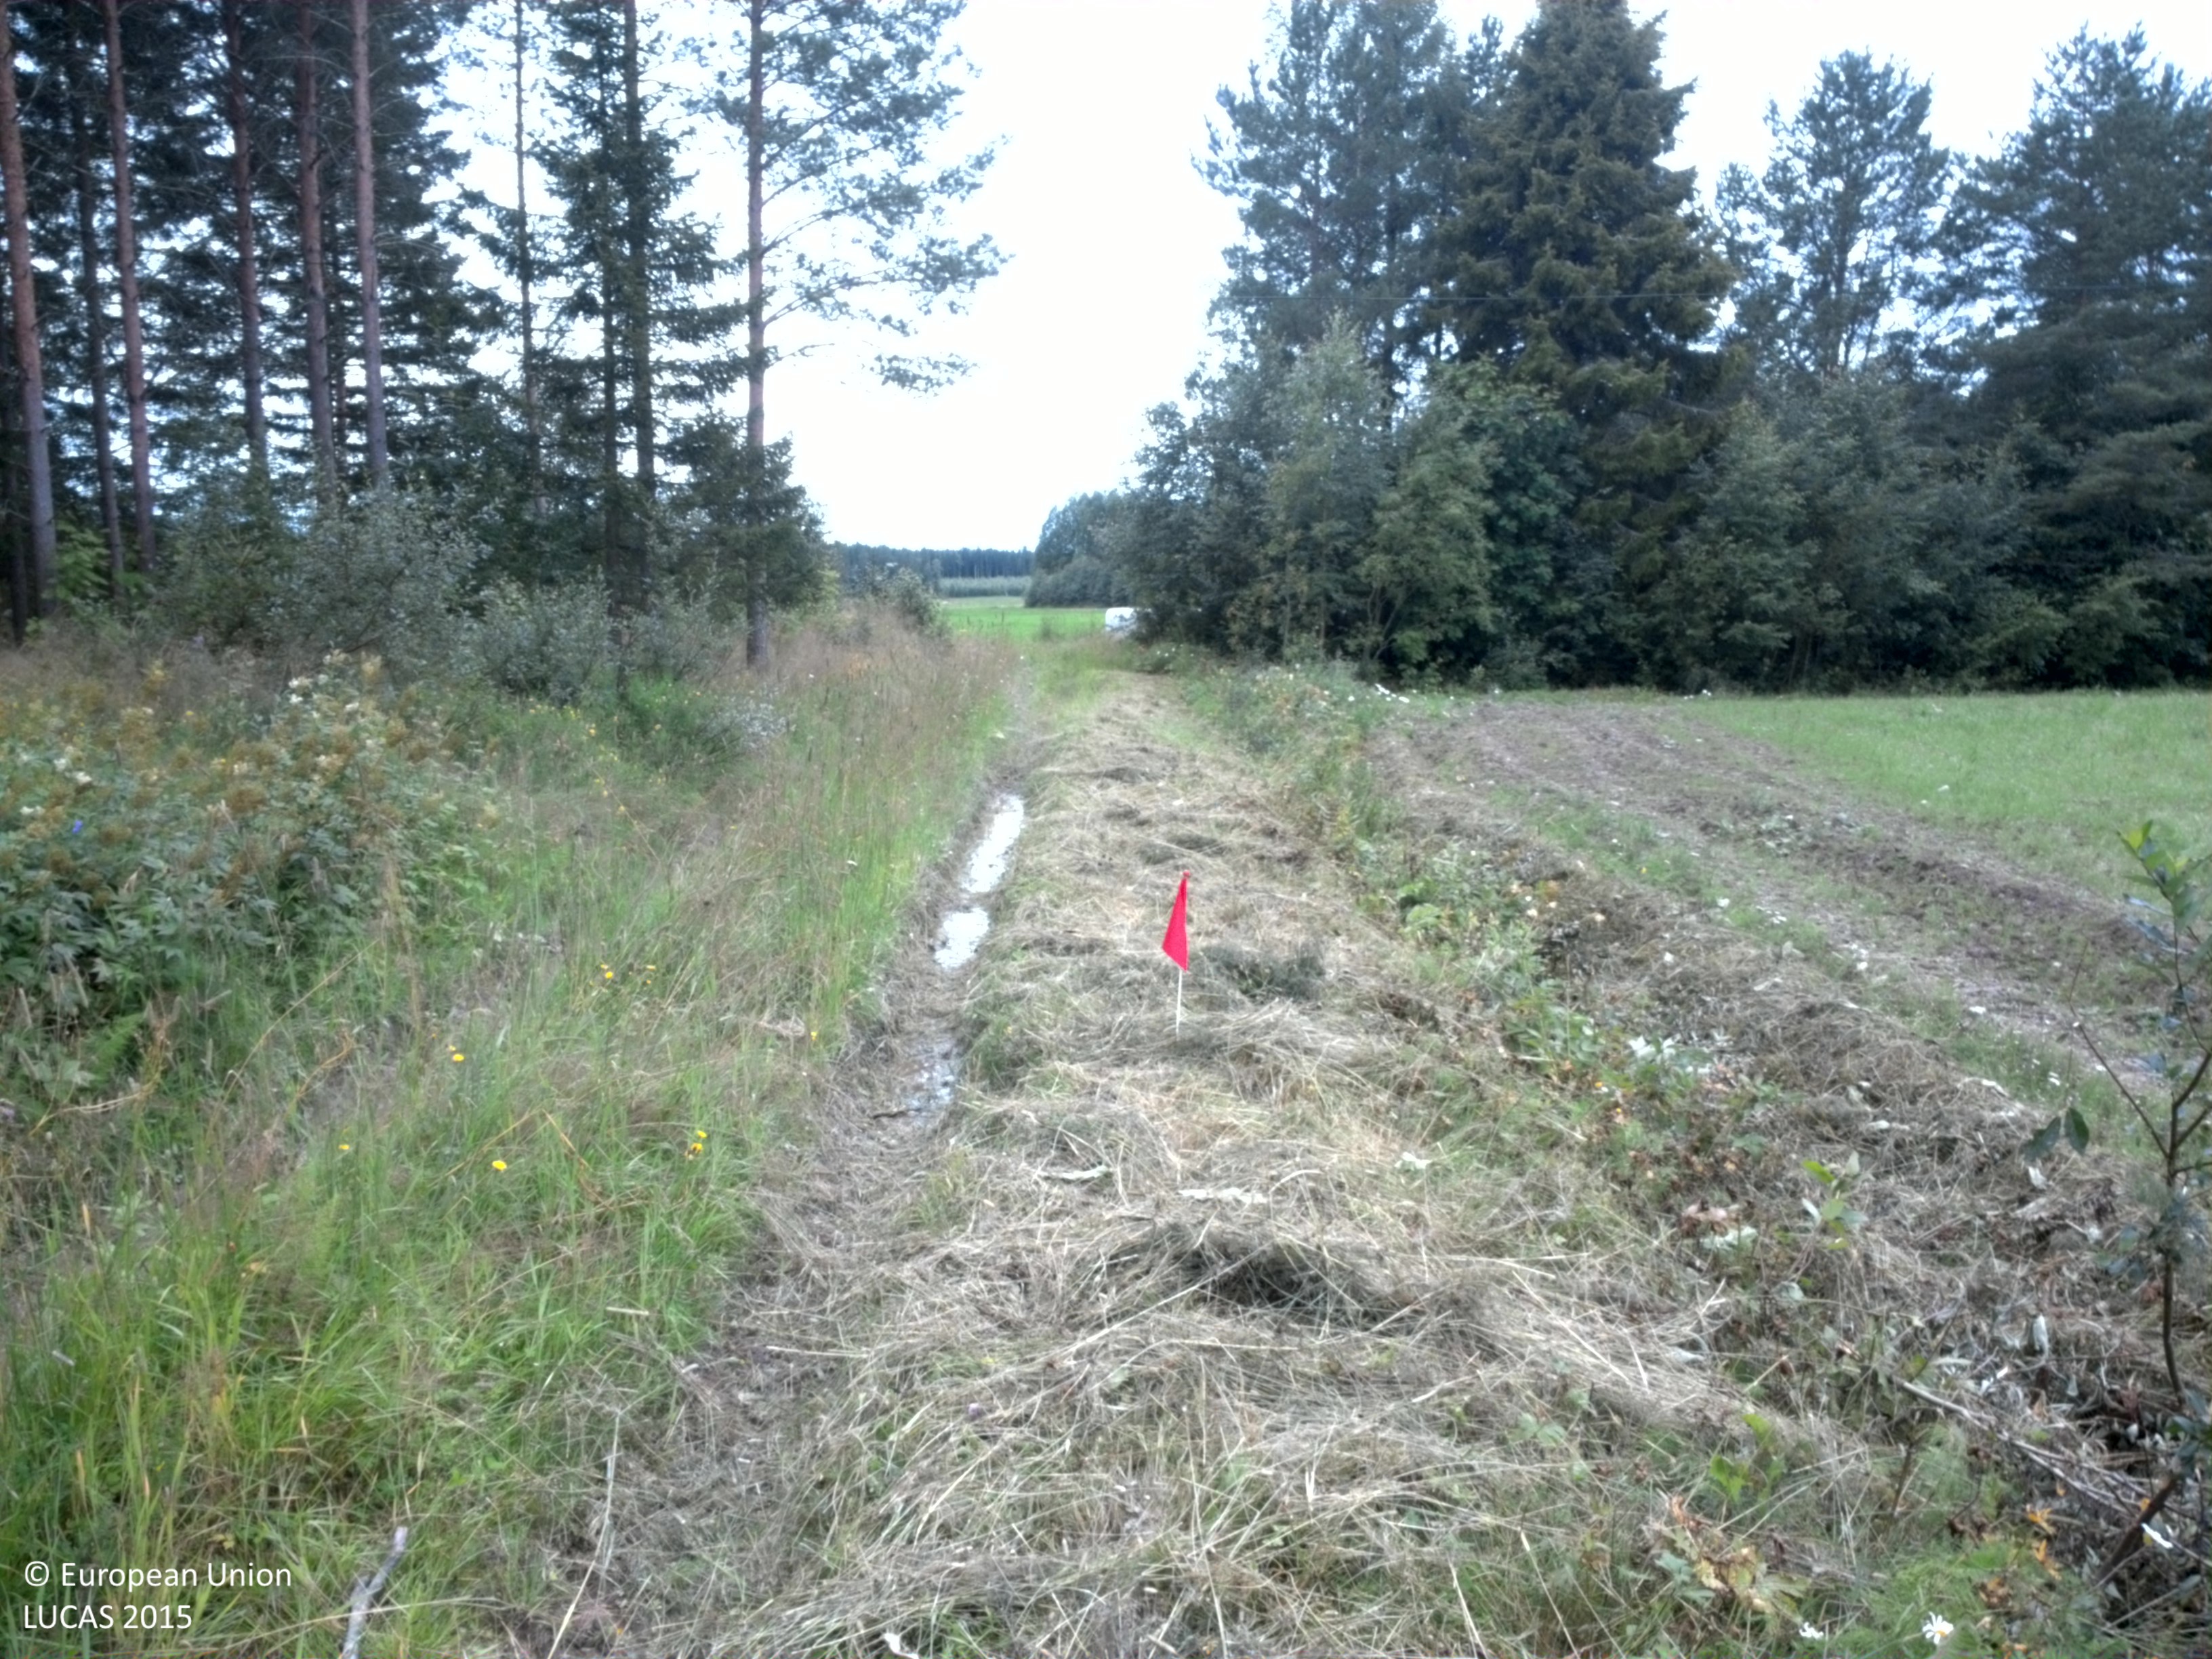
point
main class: Cropland
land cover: Temporary grasslands
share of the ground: > 75 %
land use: Agriculture (excluding fallow land and kitchen gardens)
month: August
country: SE
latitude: 64.5607
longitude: 20.7656
